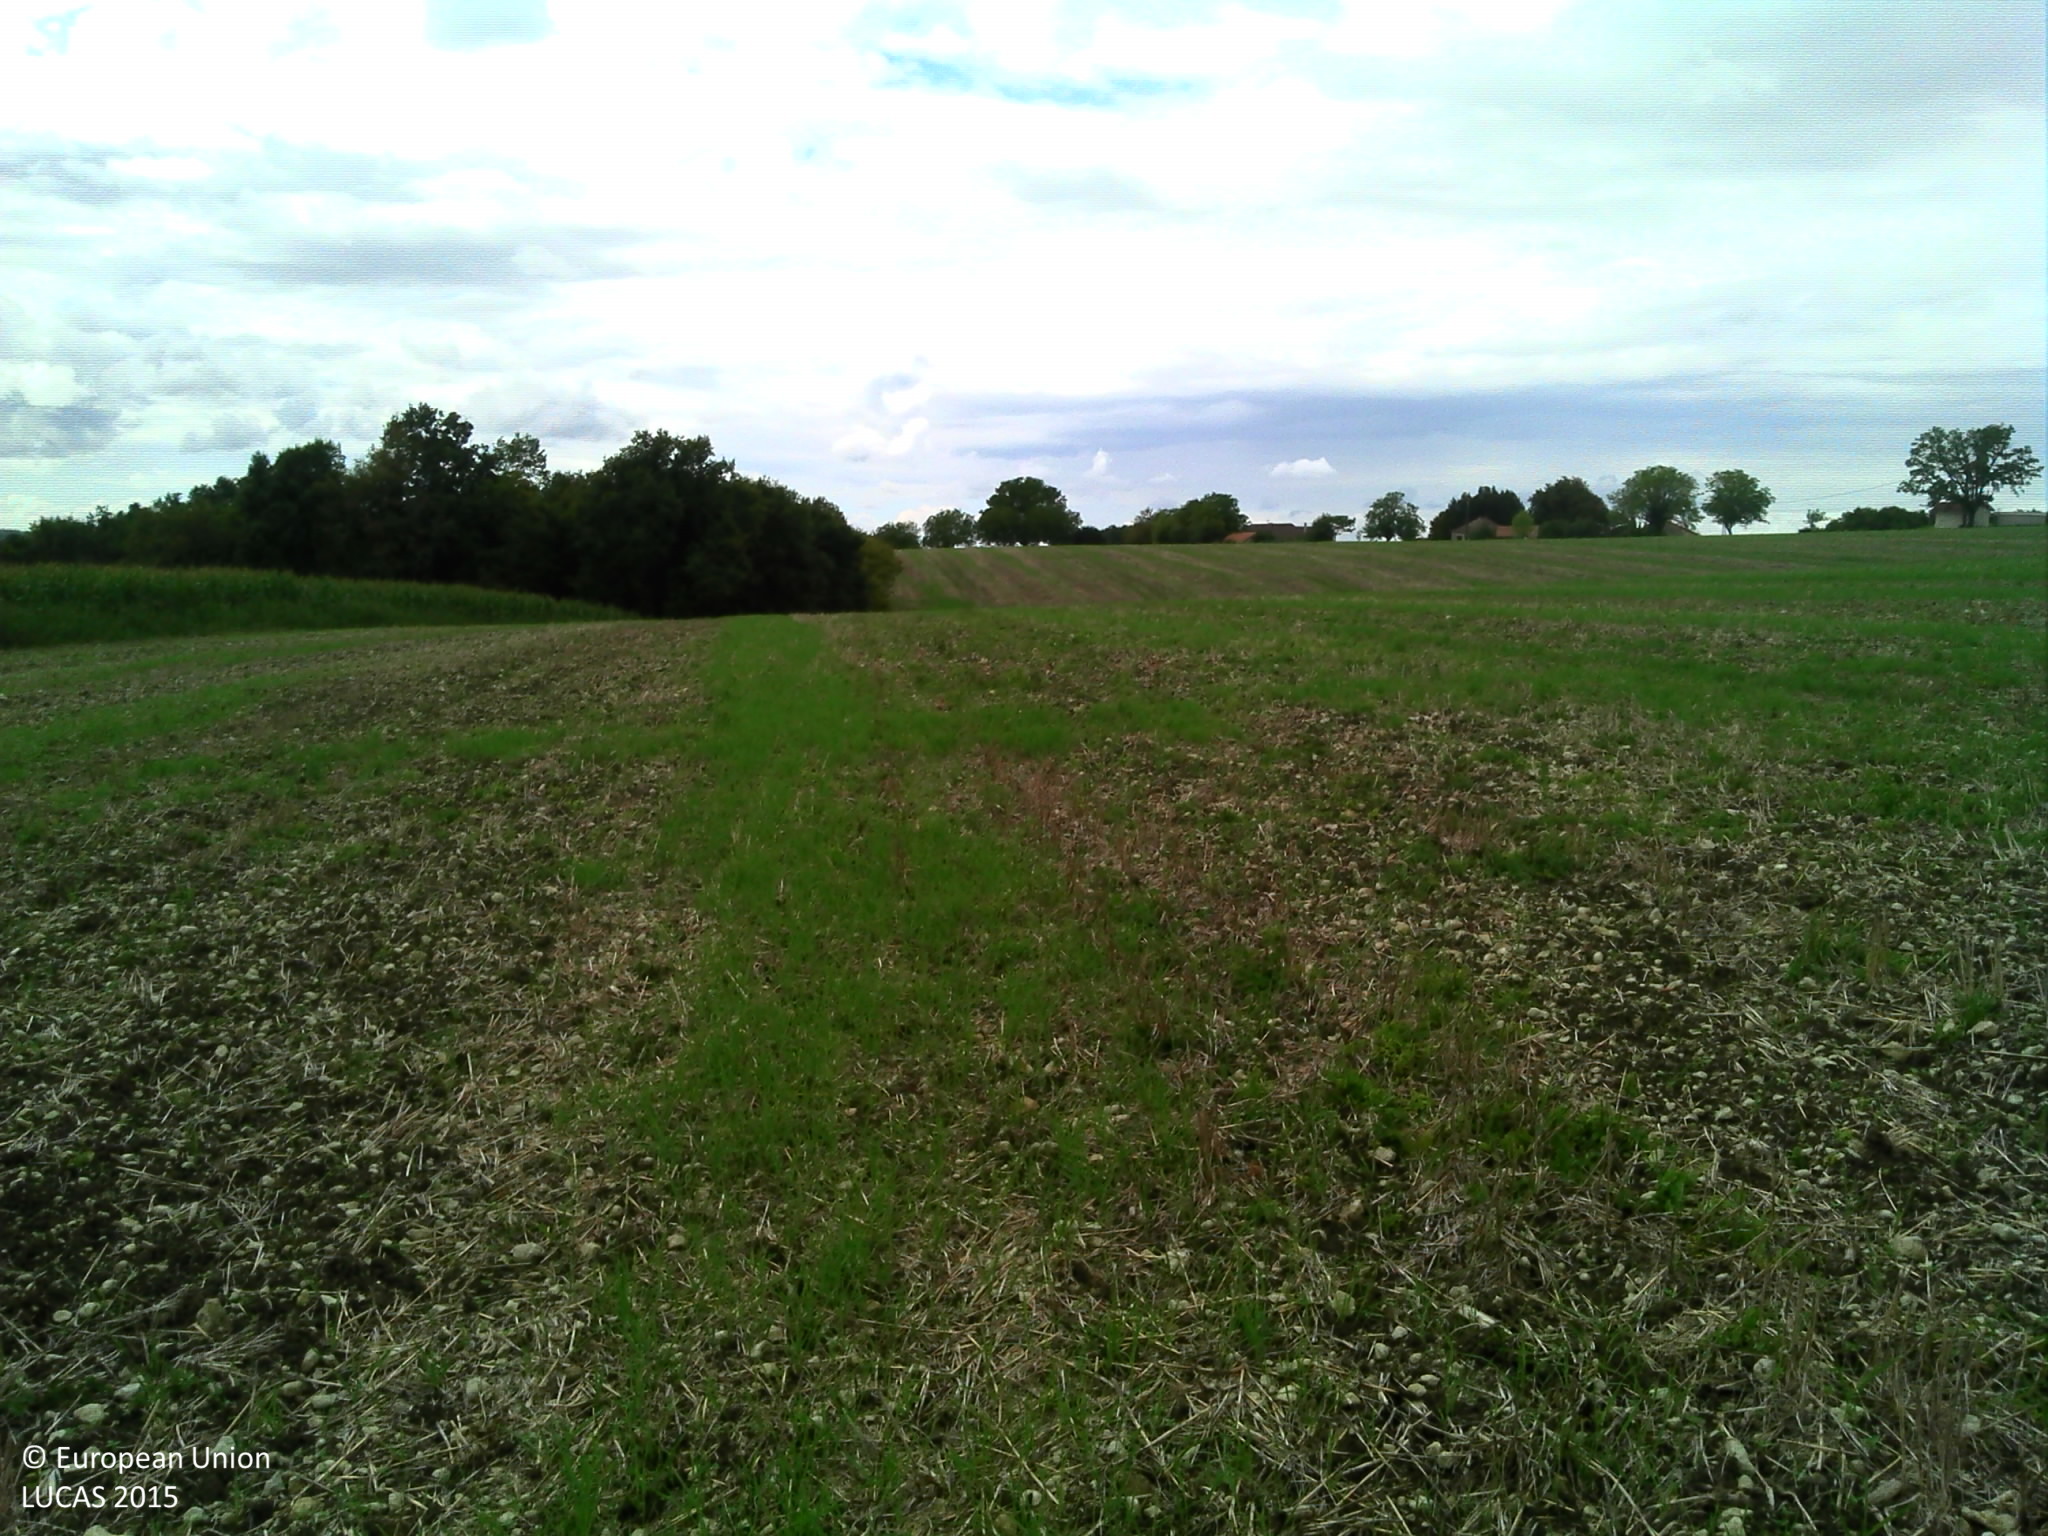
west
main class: Grassland
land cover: Spontaneously vegetated surfaces
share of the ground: 25 - 50 %
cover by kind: herbaceous plants 50 %, unconsolidated bare surface 40 %
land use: Agriculture (excluding fallow land and kitchen gardens)
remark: Harvested field
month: August
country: FR
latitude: 45.2670
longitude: 0.4159
